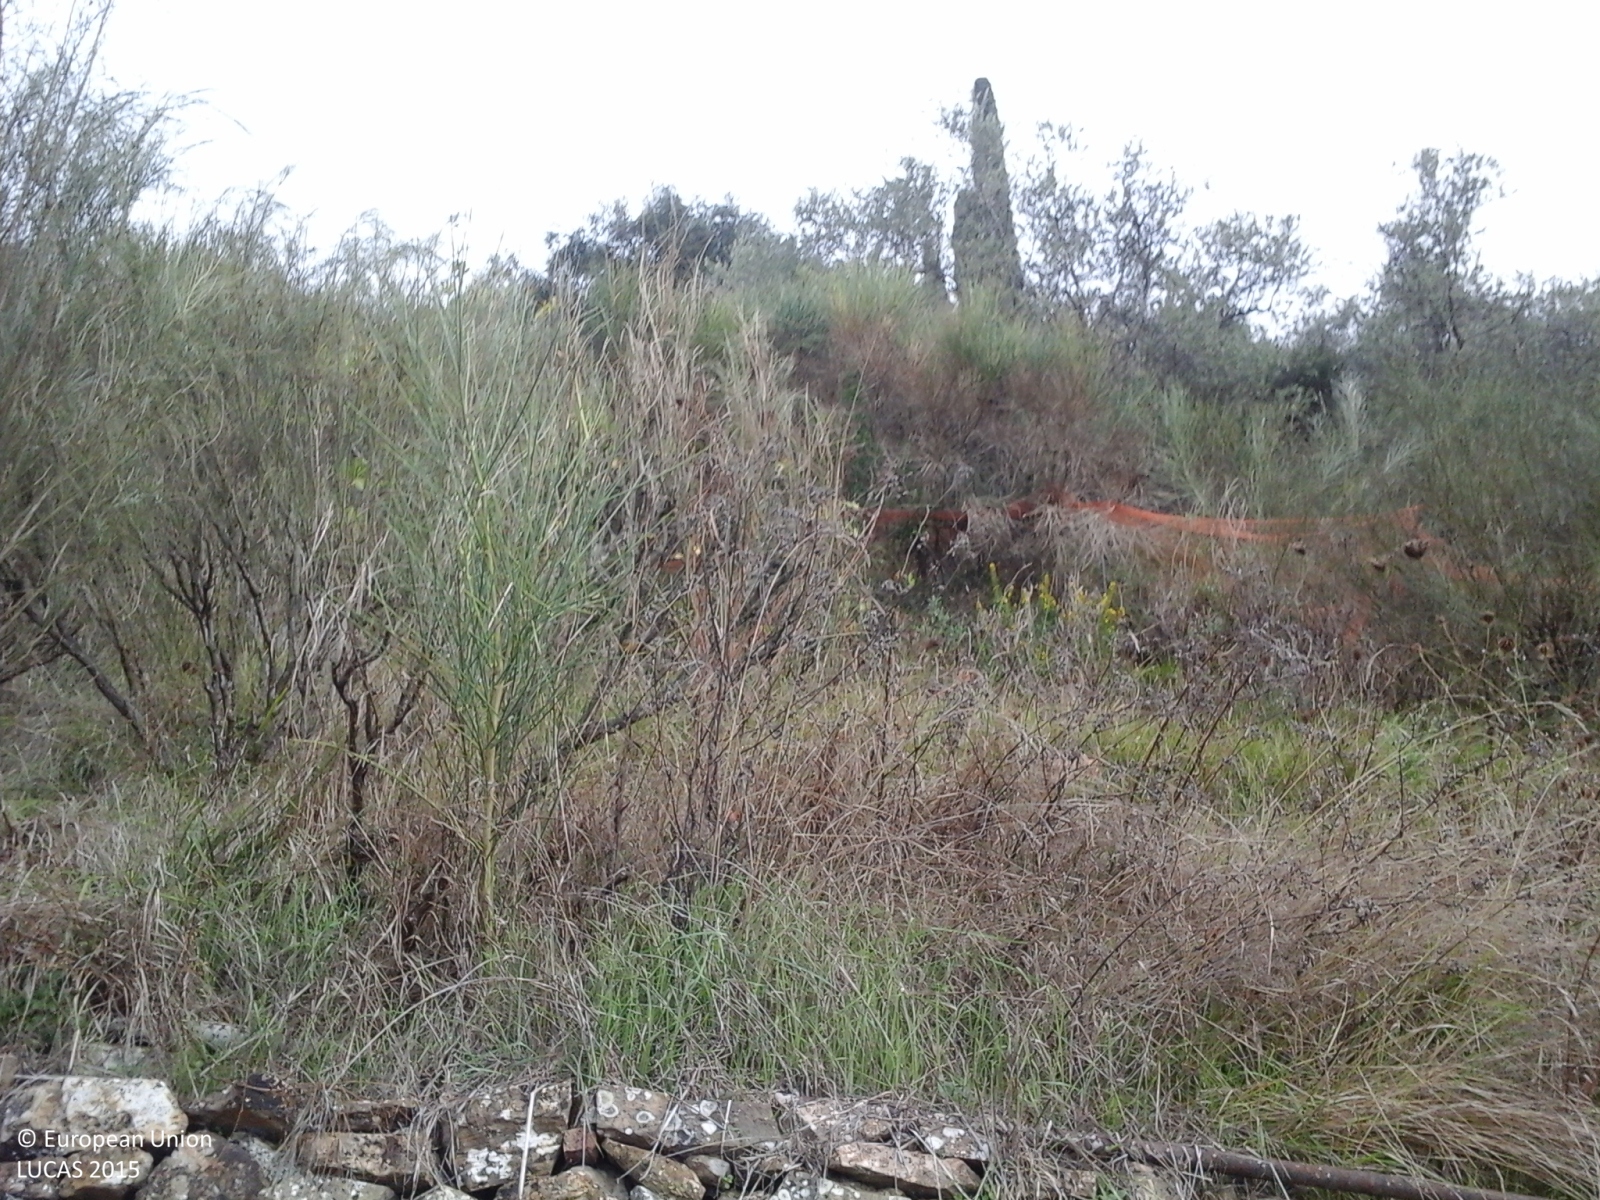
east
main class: Woodland
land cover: Broadleaved woodland
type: thermophilous deciduous forest
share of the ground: > 75 %
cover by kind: broadleaved forest trees 80 %, shrubs 15 %, herbaceous plants 5 %
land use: Semi-natural and natural areas not in use
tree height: > 5 m
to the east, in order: Shrubland without tree cover; Dry stone walls; Shrubland without tree cover; Dry stone walls; Broadleaved woodland; Permanent crops (only in case pi); Artificial constructions in urban areas; Permanent crops (only in case pi); Dry stone walls; Permanent crops (only in case pi); Tracks; Broadleaved woodland; Tracks; Shrubland with sparse tree cover; Permanent crops (only in case pi); Dry stone walls; Permanent crops (only in case pi); Dry stone walls; Permanent crops (only in case pi); Dry stone walls; Permanent crops (only in case pi); Dry stone walls; Permanent crops (only in case pi); Dry stone walls; Permanent crops (only in case pi); Dry stone walls; Permanent crops (only in case pi); Dry stone walls; Permanent crops (only in case pi); Dry stone walls; Floriculture and ornamental plants; Dry stone walls; Floriculture and ornamental plants
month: October
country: IT
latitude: 43.8194
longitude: 7.6807
